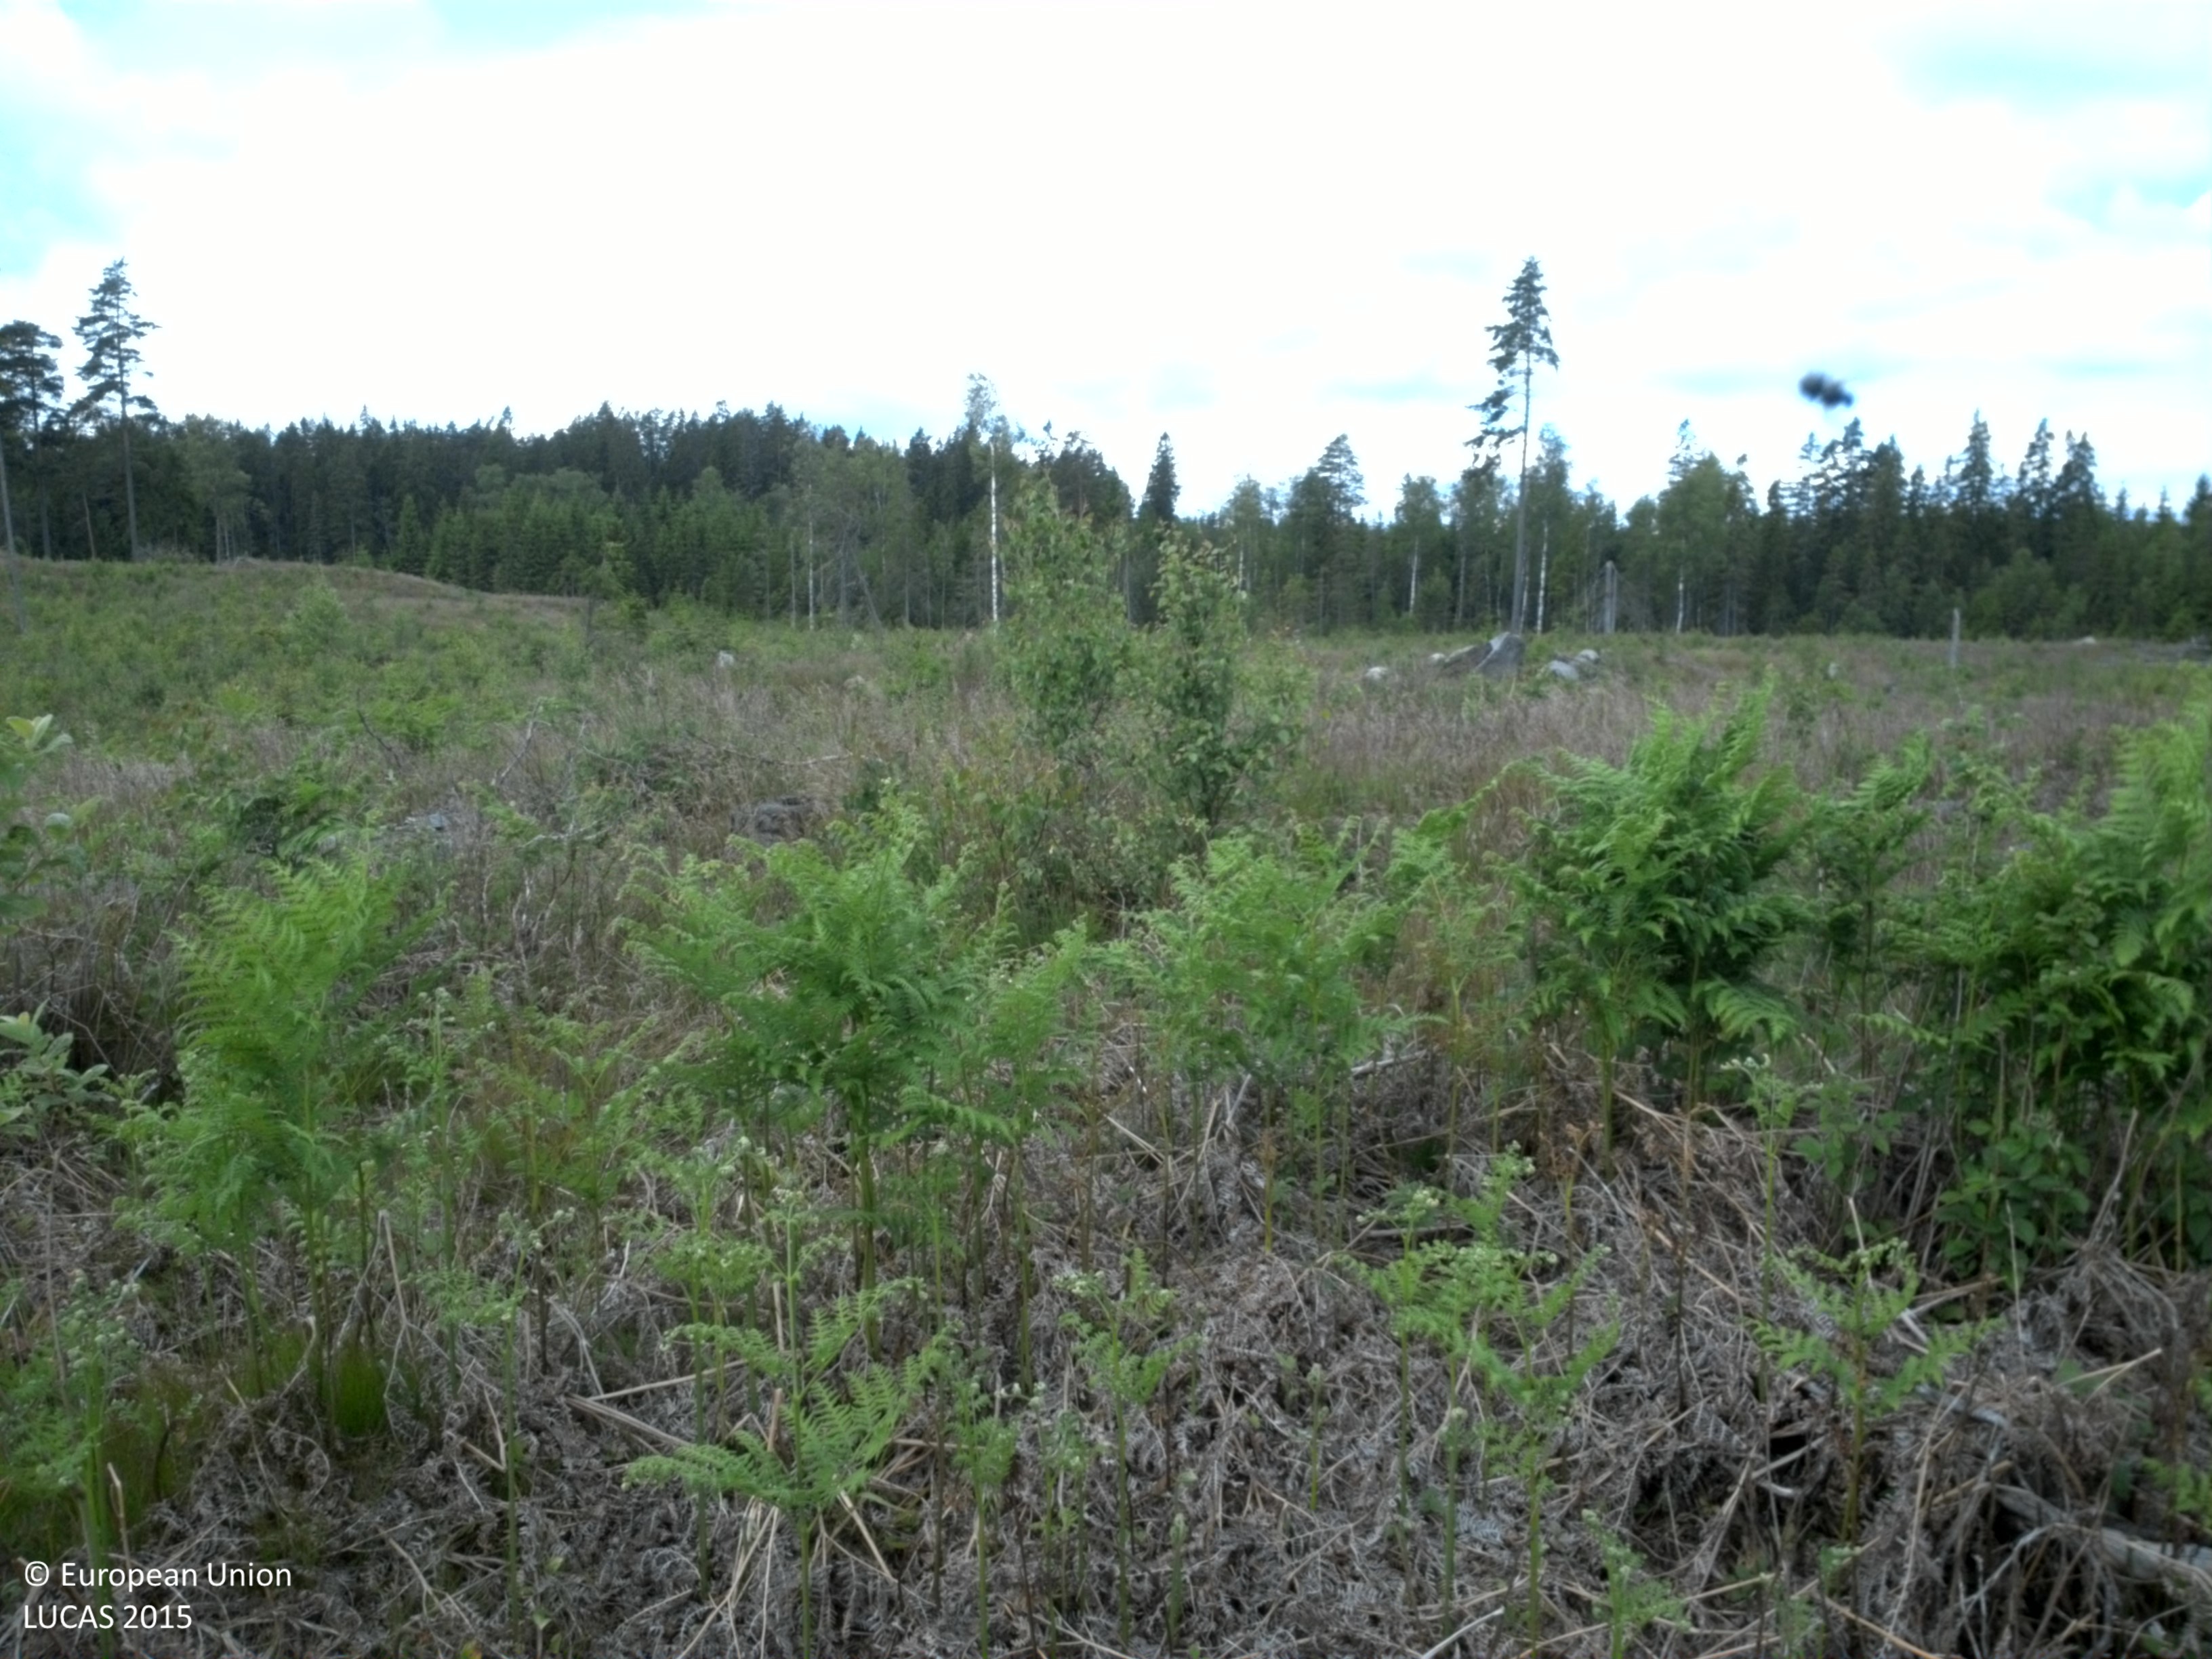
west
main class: Woodland
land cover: Spruce dominated mixed woodland
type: boreal forest
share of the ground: 50 - 75 %
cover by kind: coniferous forest trees 35 %, herbaceous plants 30 %, broadleaved forest trees 25 %, lichens and mosses 10 %
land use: Forestry
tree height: < 5 m
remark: Clear cut
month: June
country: SE
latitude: 58.6484
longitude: 15.4907
